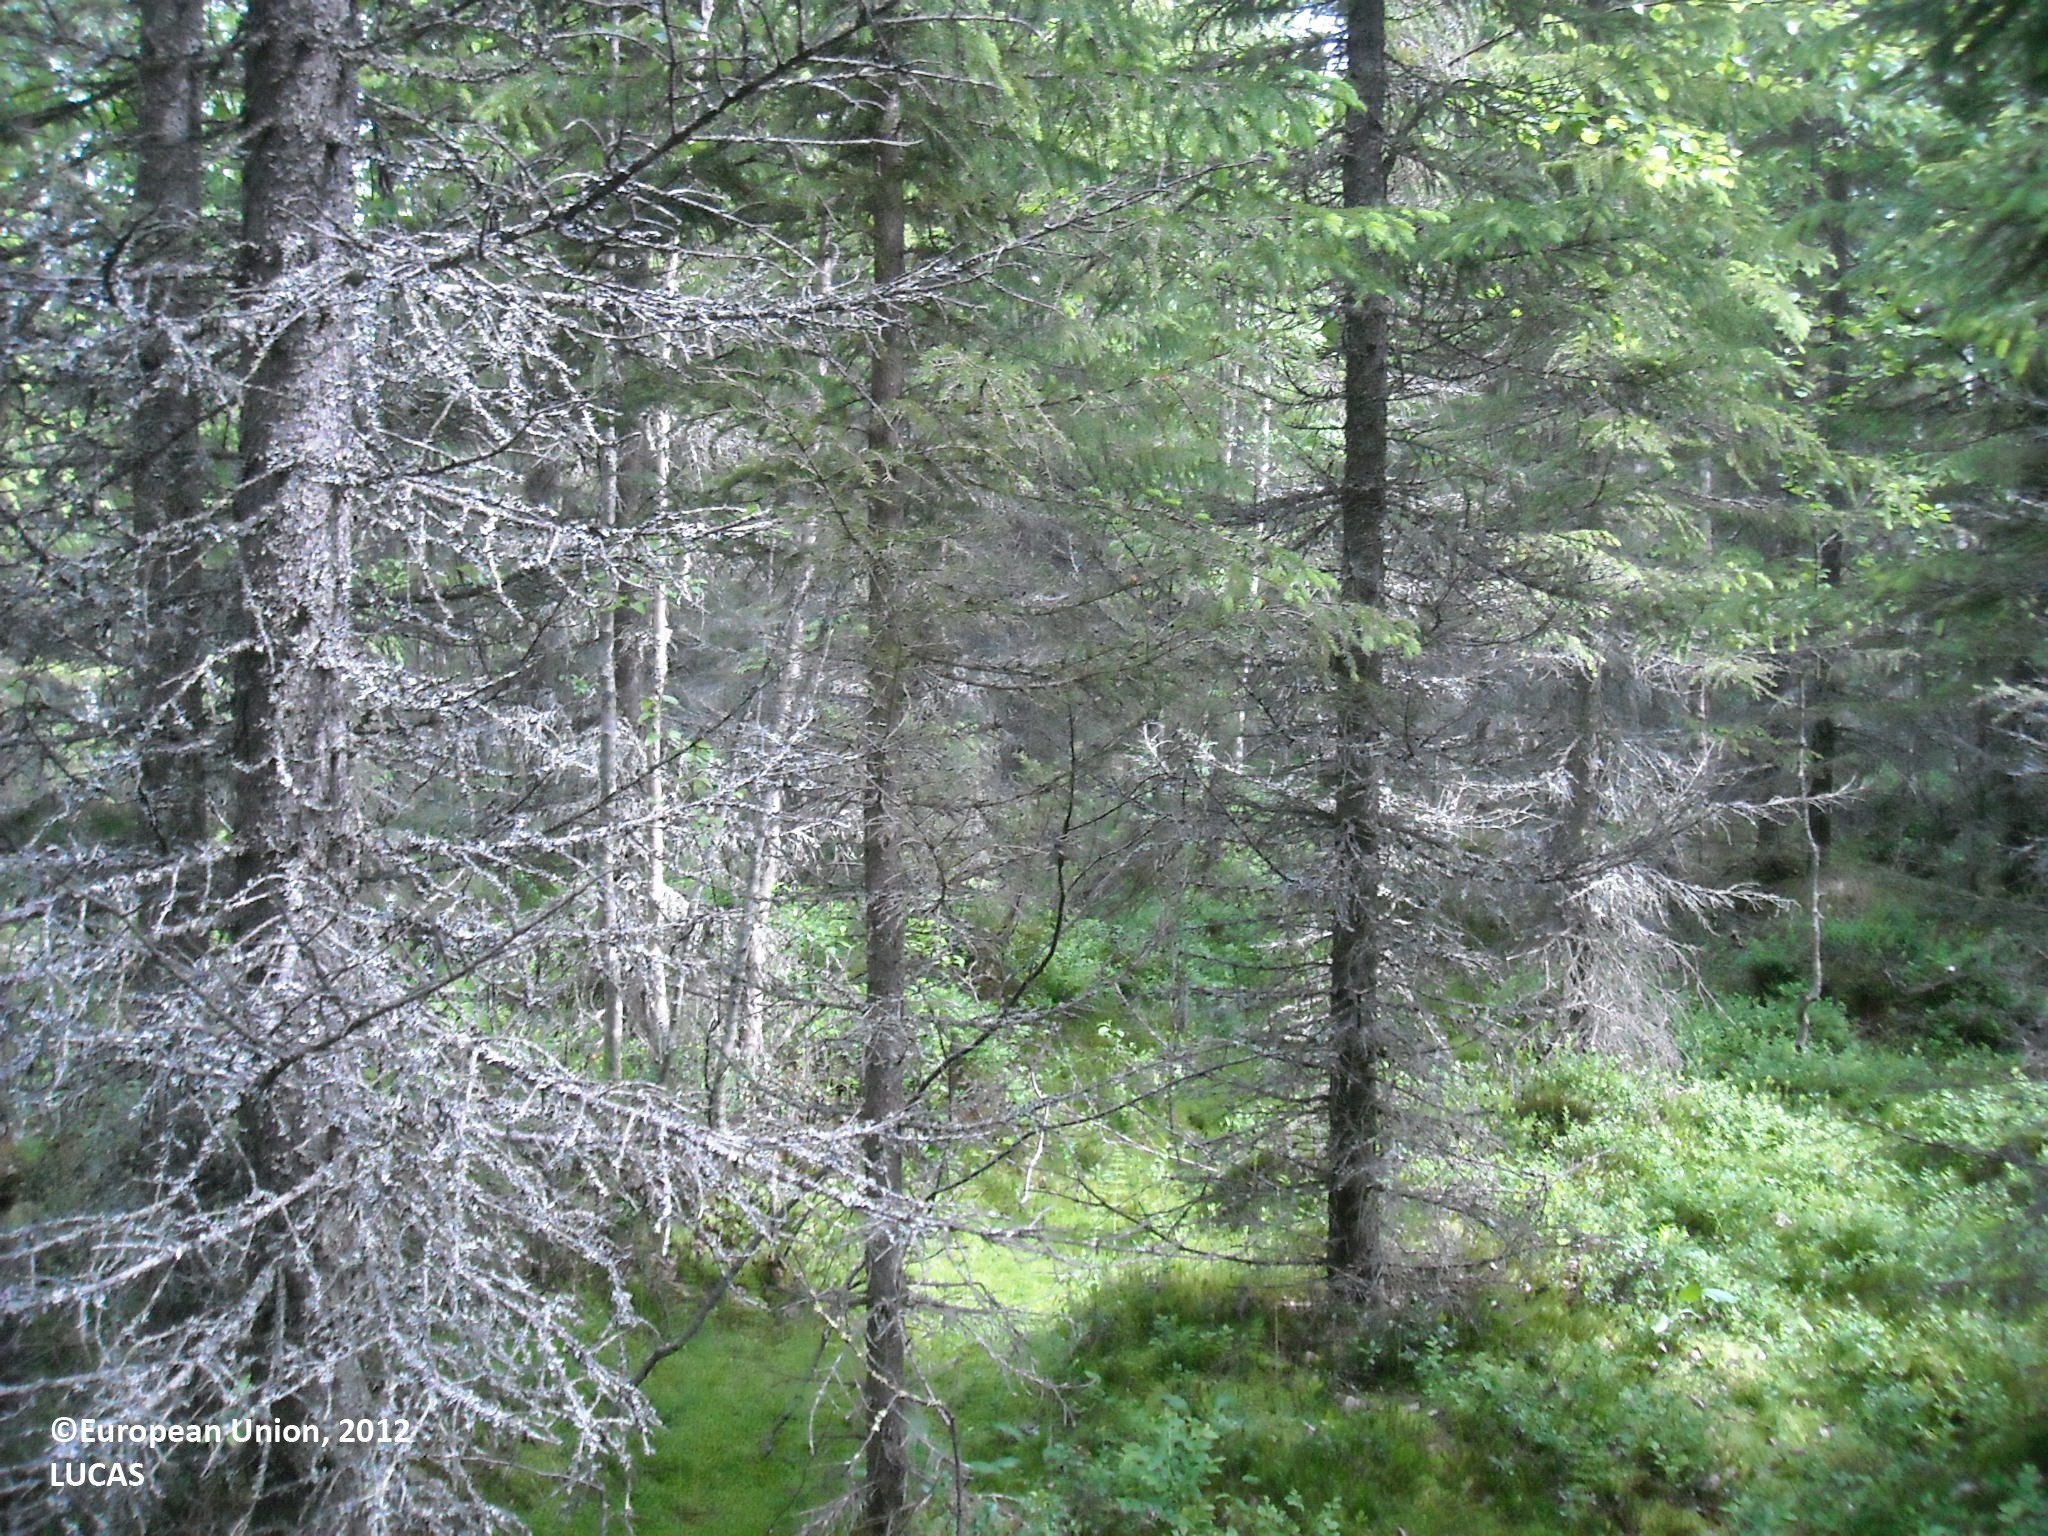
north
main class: Woodland
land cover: Spruce dominated coniferous woodland
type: boreal forest
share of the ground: > 75 %
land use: Forestry
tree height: > 5 m
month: June
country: FI
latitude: 64.8067
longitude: 27.8572
